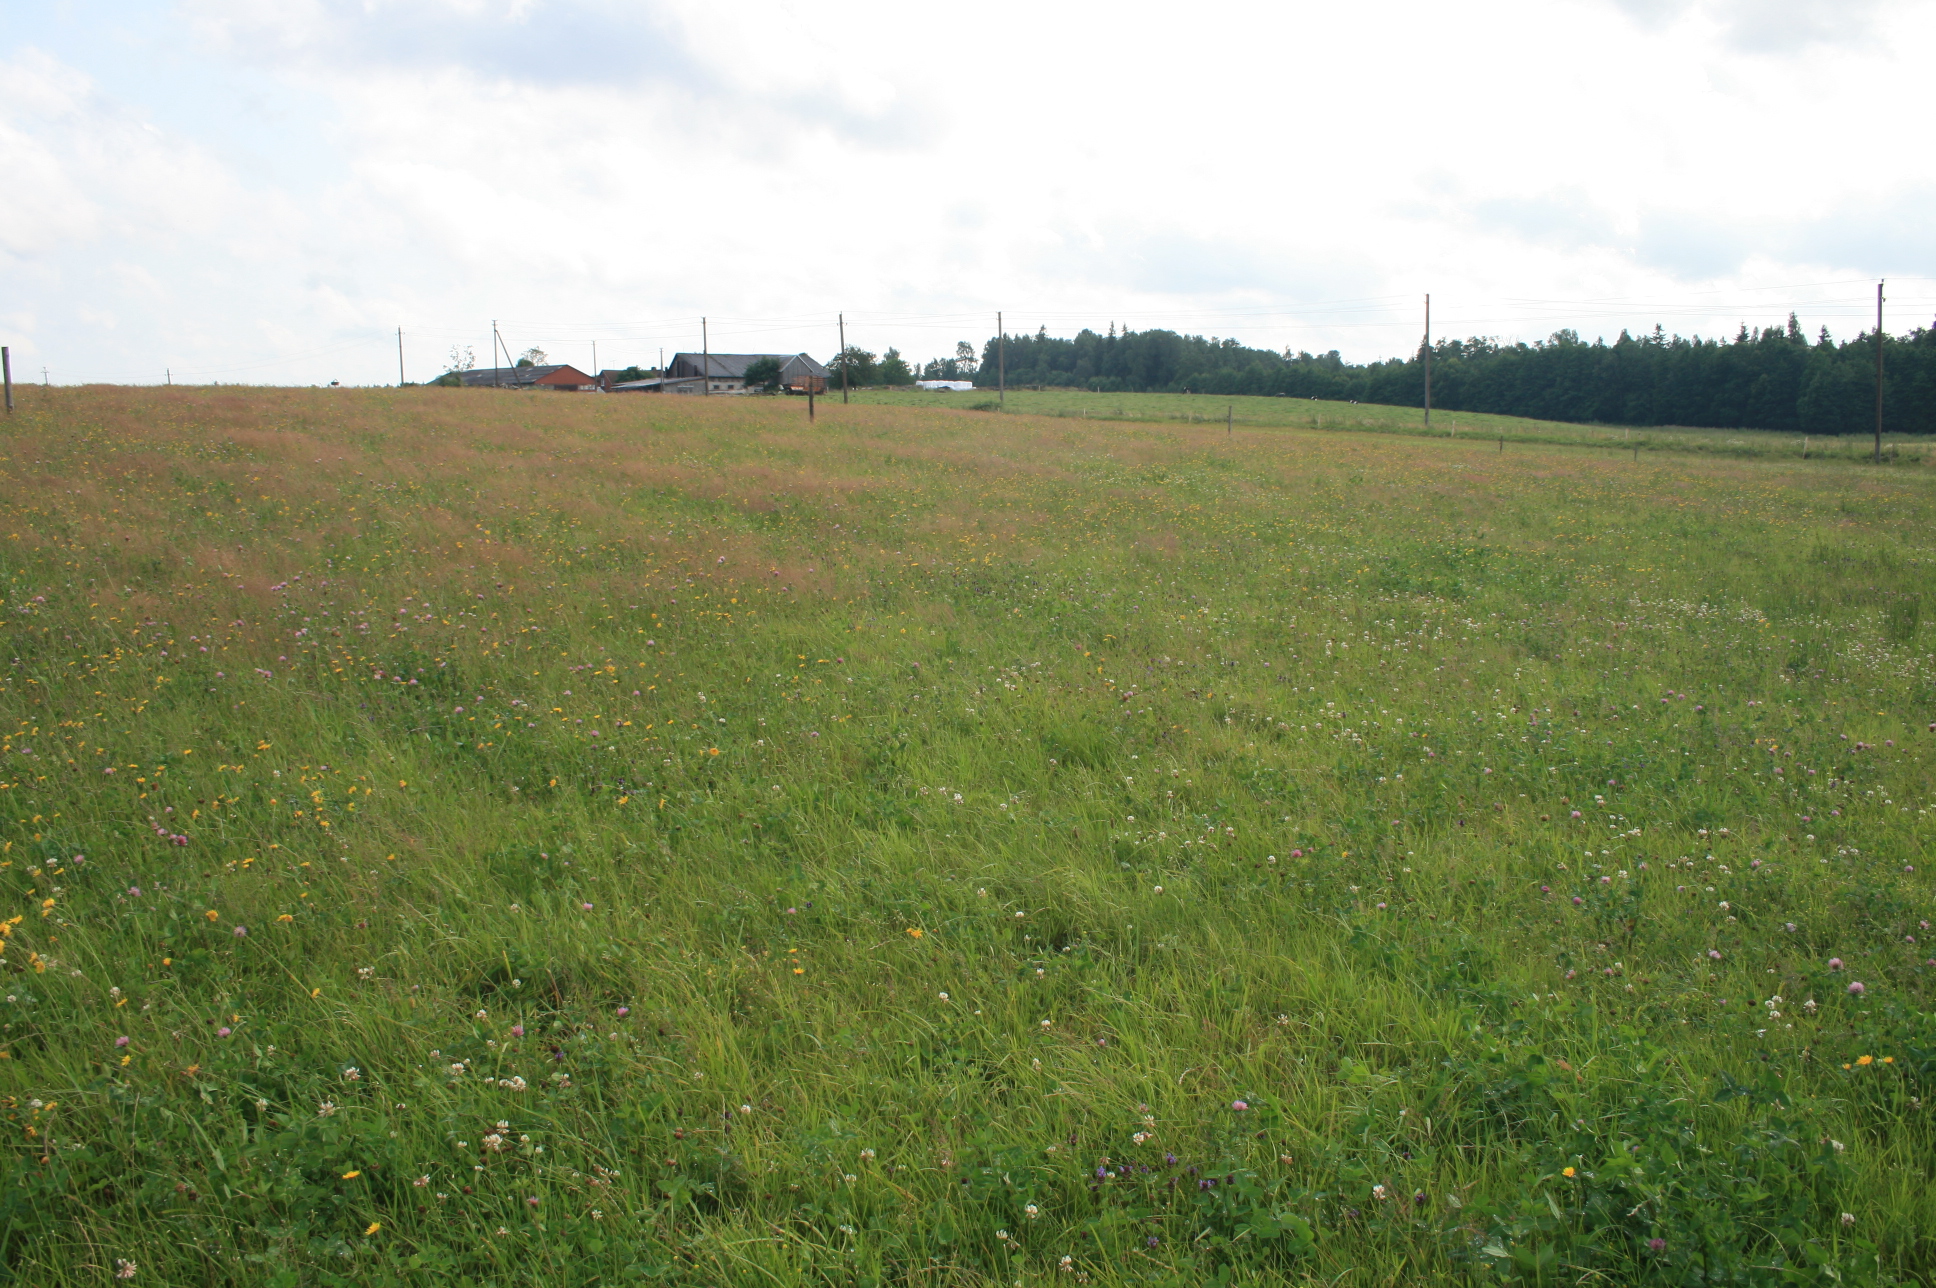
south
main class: Grassland
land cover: Grassland without tree/shrub cover
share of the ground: > 75 %
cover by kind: herbaceous plants 100 %
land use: Agriculture (excluding fallow land and kitchen gardens)
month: July
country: LT
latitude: 55.5299
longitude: 21.8214
